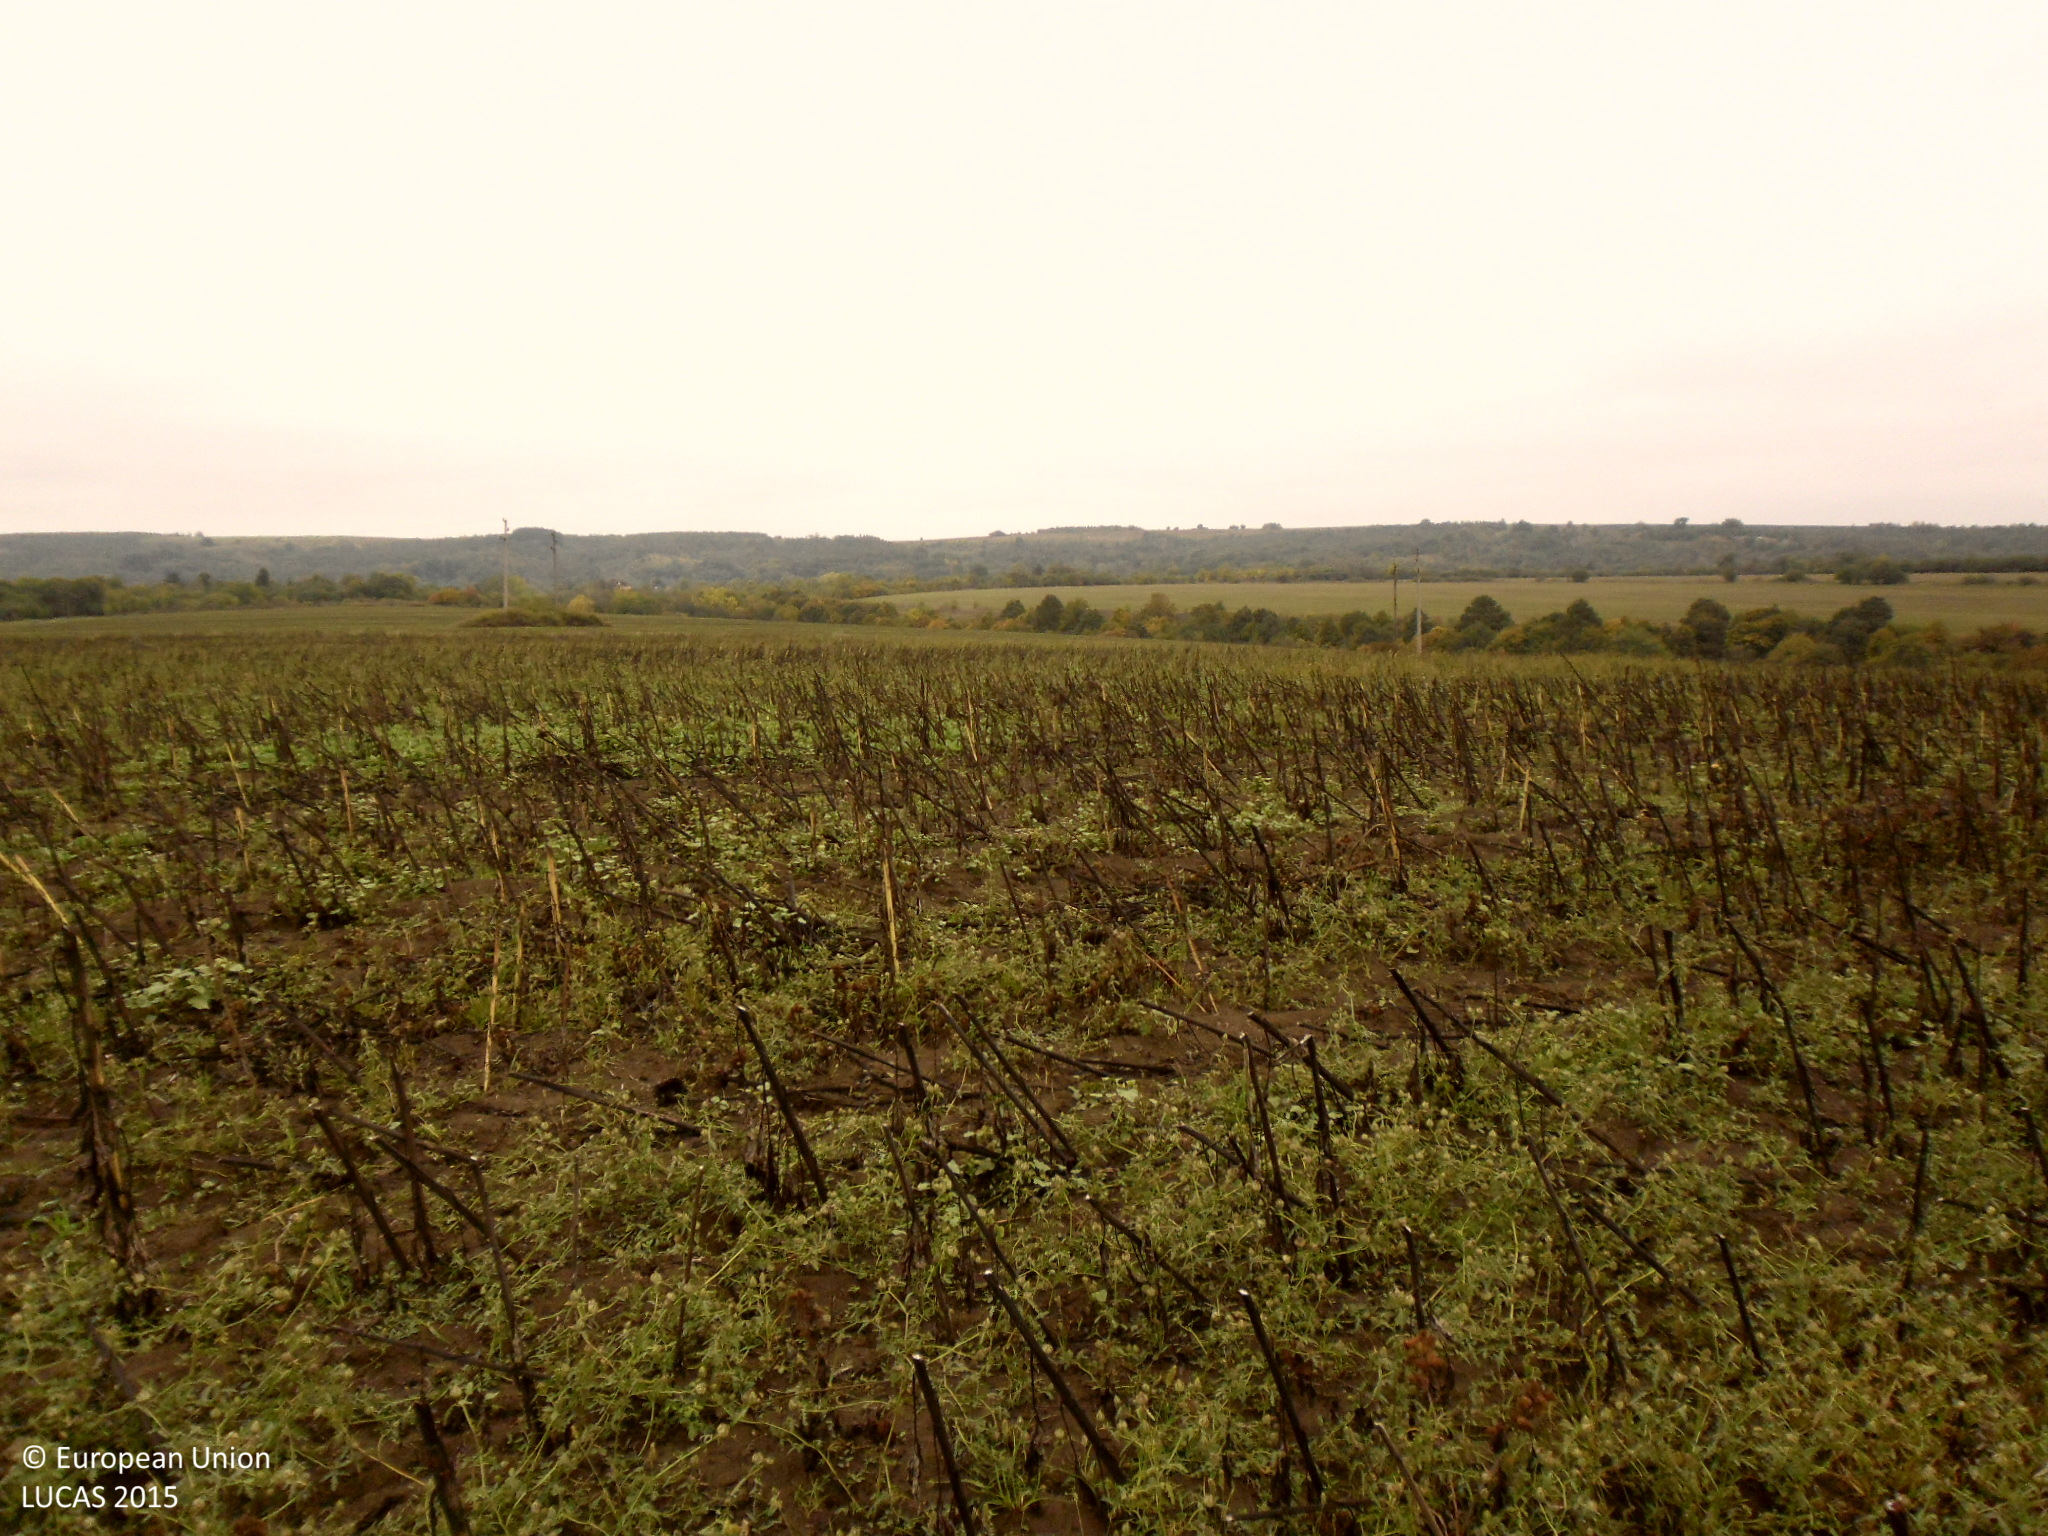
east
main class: Cropland
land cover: Sunflower
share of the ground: 10 - 25 %
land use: Agriculture (excluding fallow land and kitchen gardens)
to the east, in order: Sunflower; Tracks; Common wheat; Electric lines; Single bushes/trees; Common wheat; Electric lines; Common wheat
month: October
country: BG
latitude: 43.6788
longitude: 22.8249
